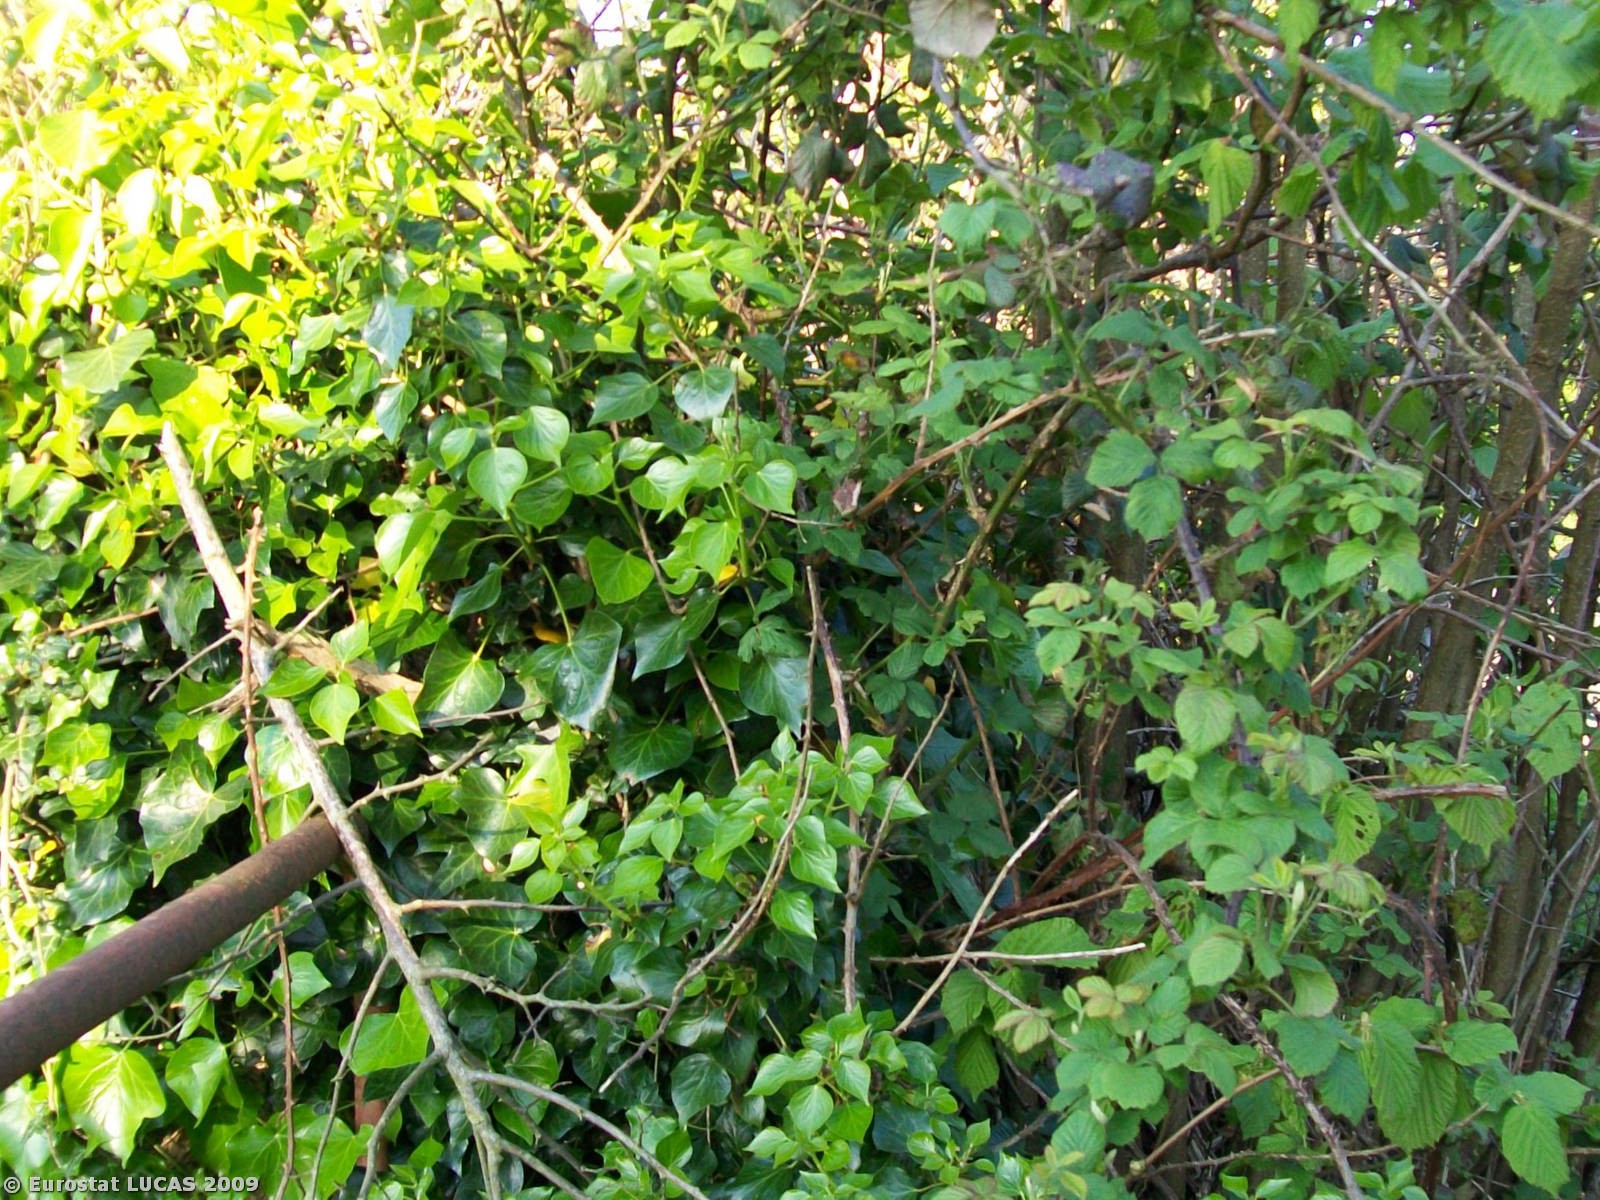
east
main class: Grassland
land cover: Grassland without tree/shrub cover
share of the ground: > 75 %
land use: Agriculture (excluding fallow land and kitchen gardens)
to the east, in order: Grassland without tree/shrub cover; Fences; Grassland without tree/shrub cover; Fences; Grassland without tree/shrub cover
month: May
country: IE
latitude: 52.0692
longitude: -8.2603
